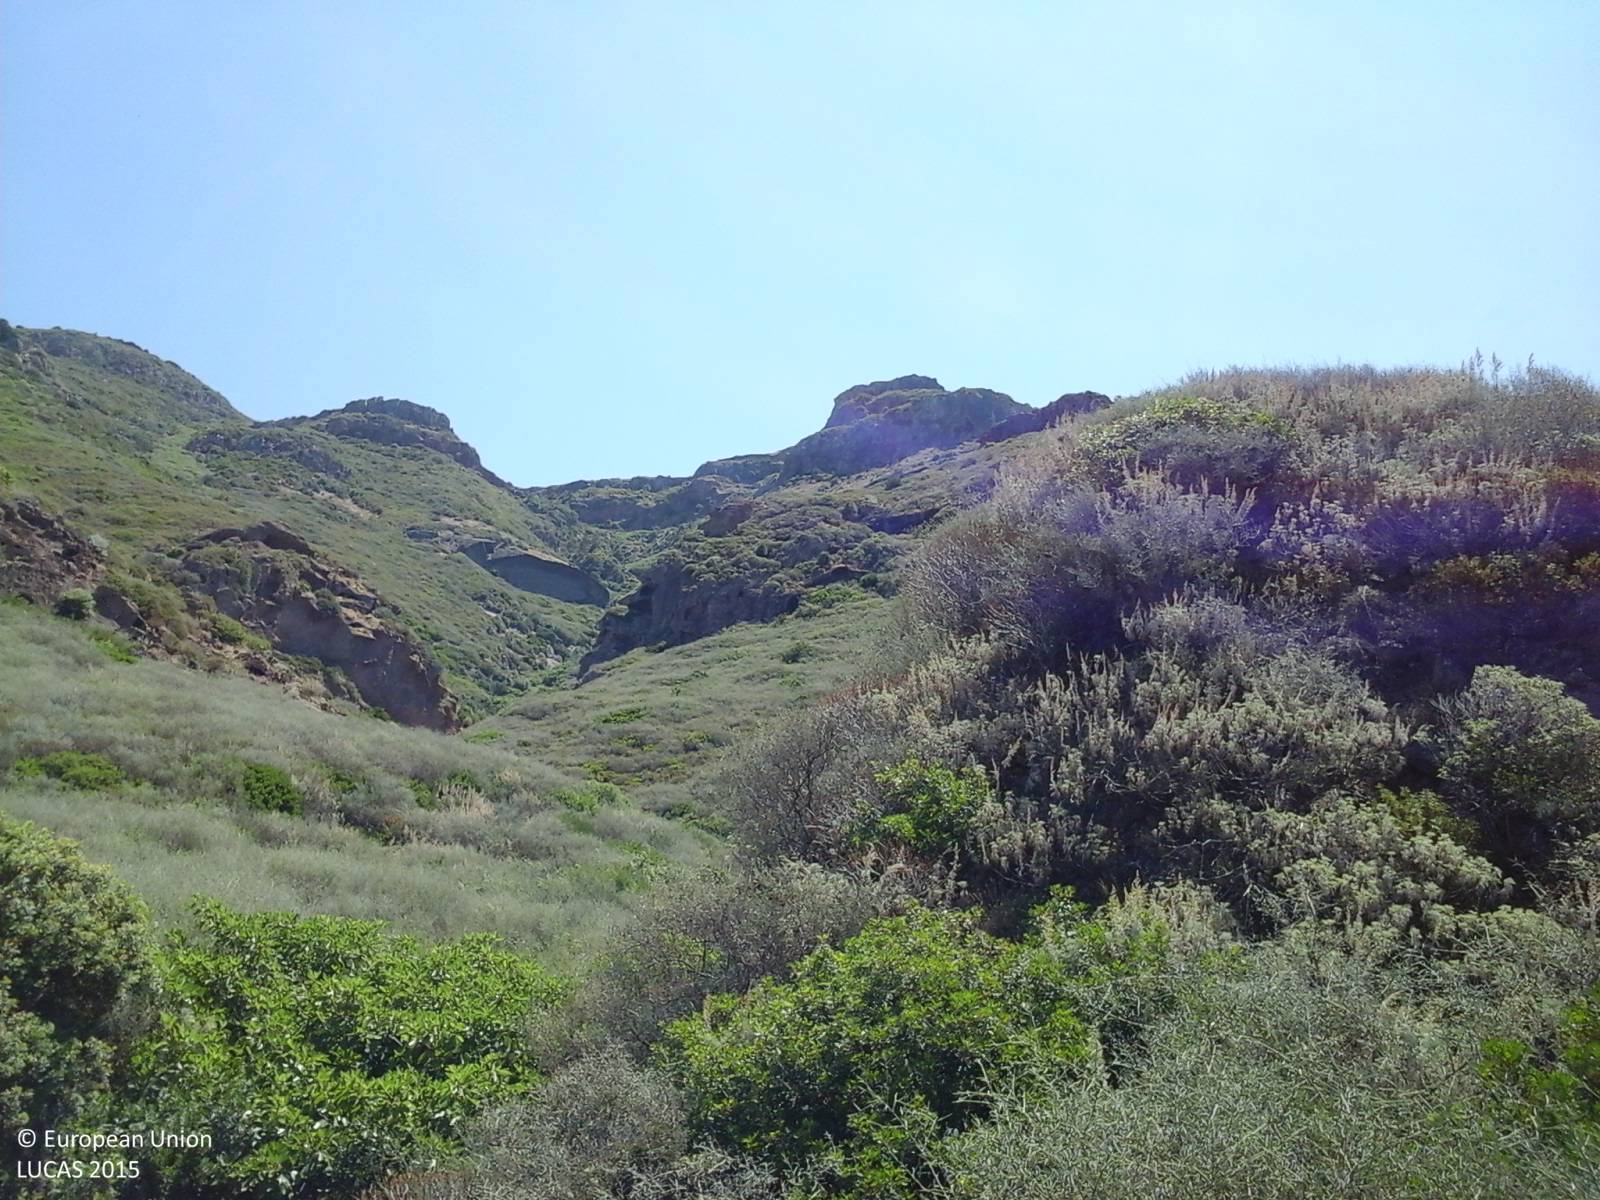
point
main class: Shrubland
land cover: Shrubland without tree cover
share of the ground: > 75 %
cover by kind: shrubs 90 %, consolidated bare surface 10 %
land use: Semi-natural and natural areas not in use
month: June
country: IT
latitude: 40.4533
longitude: 8.3926
